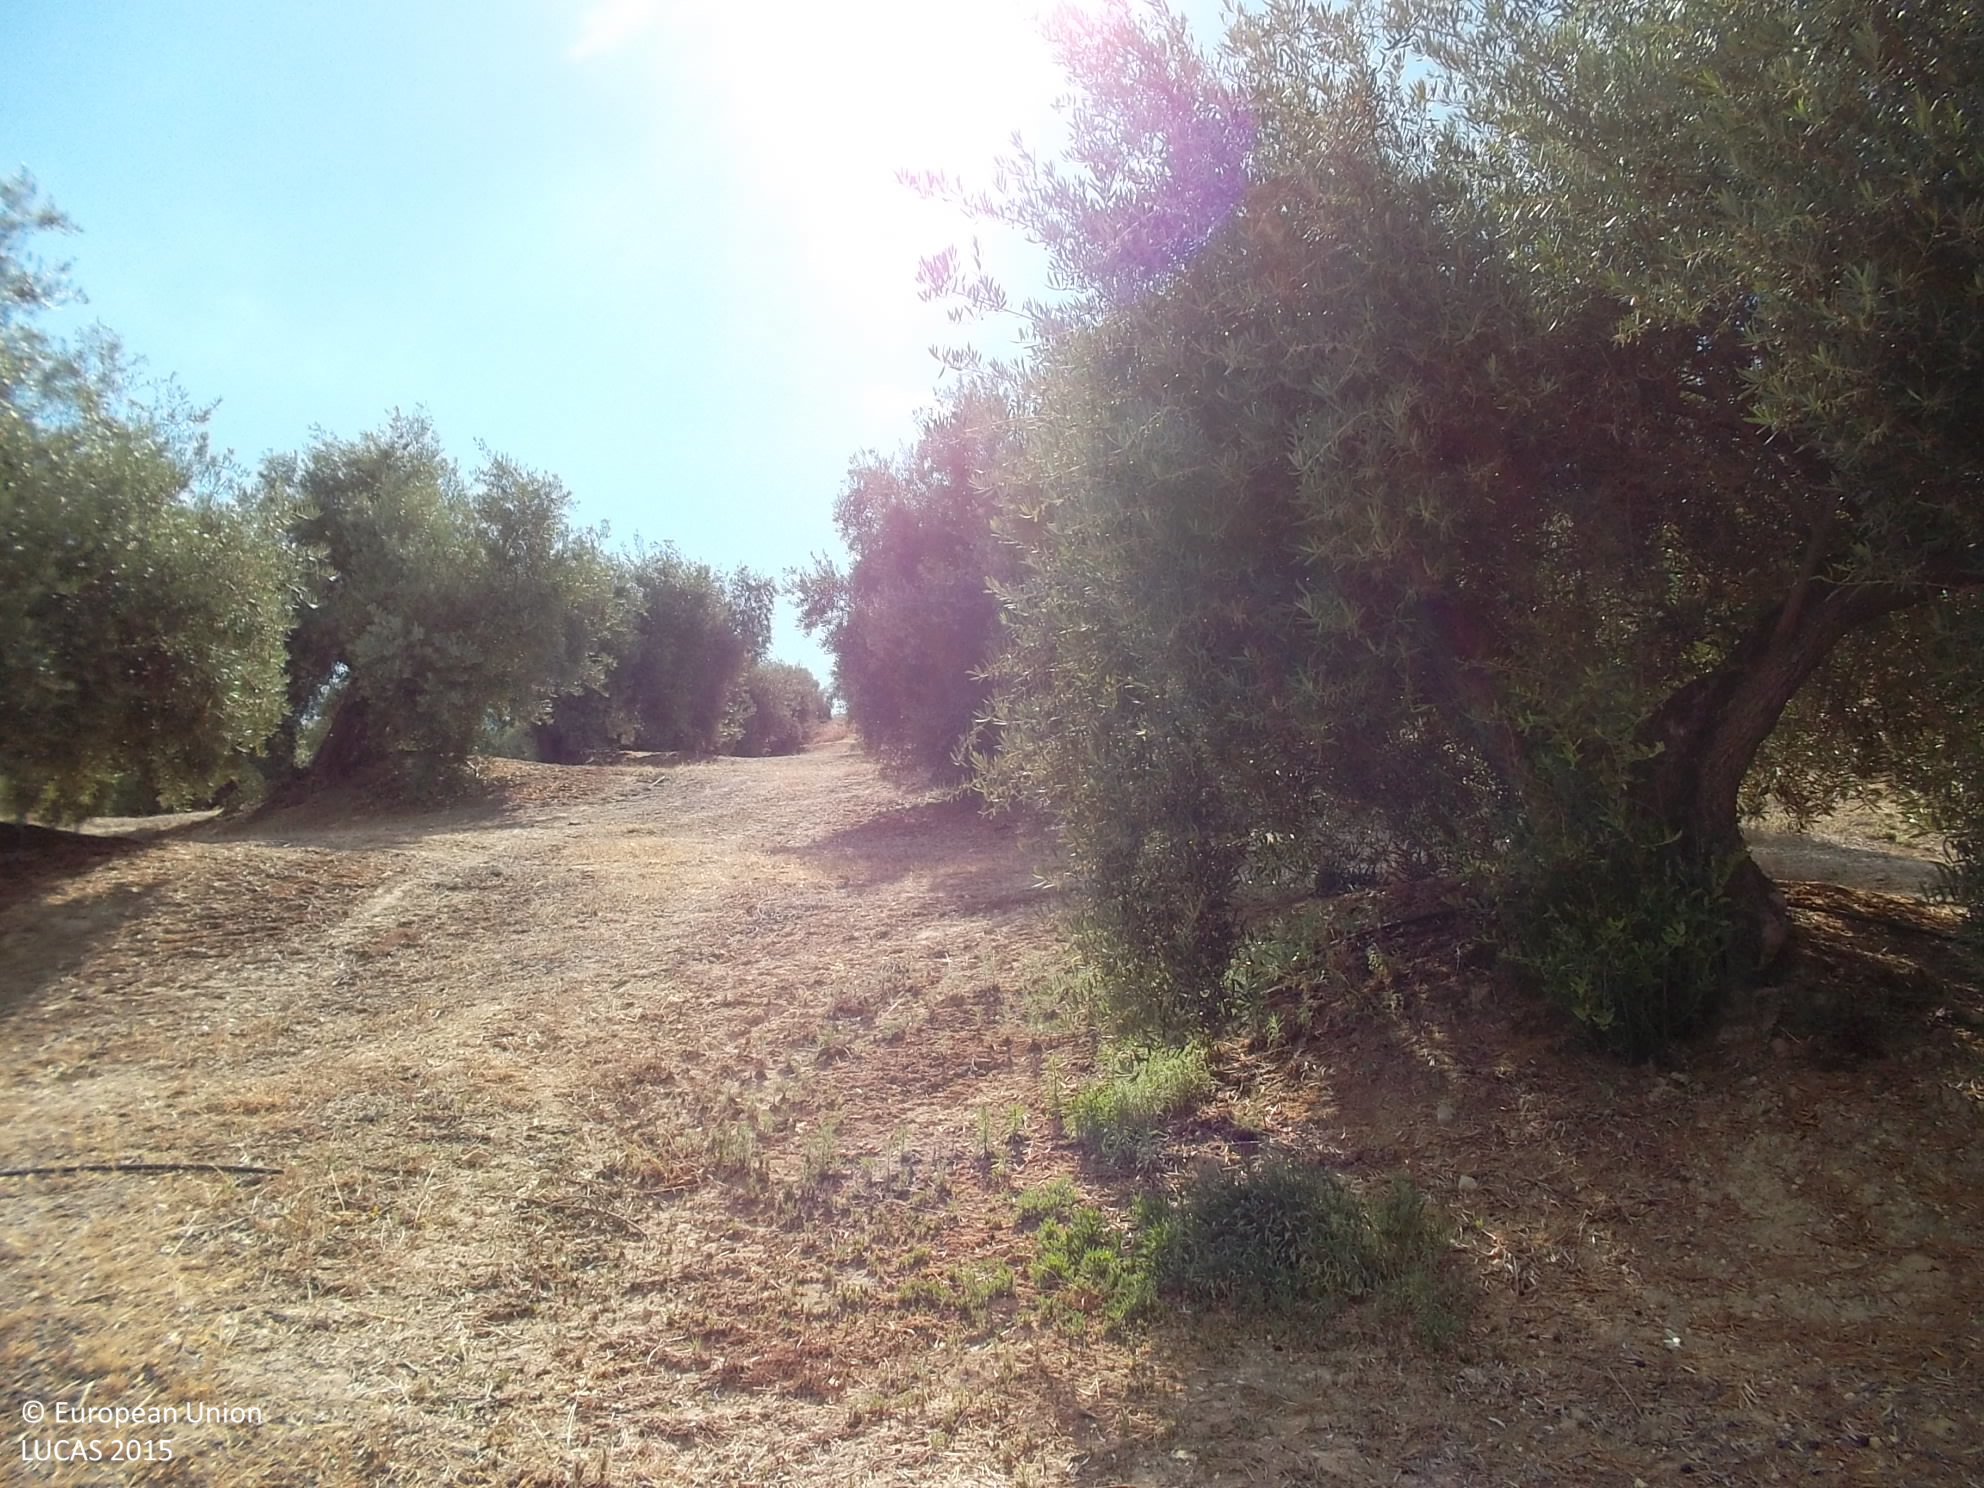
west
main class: Cropland
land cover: Olive groves
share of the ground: 50 - 75 %
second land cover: Other bare soil
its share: > 75 %
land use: Agriculture (excluding fallow land and kitchen gardens)
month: June
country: ES
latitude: 38.0045
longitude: -3.0138
